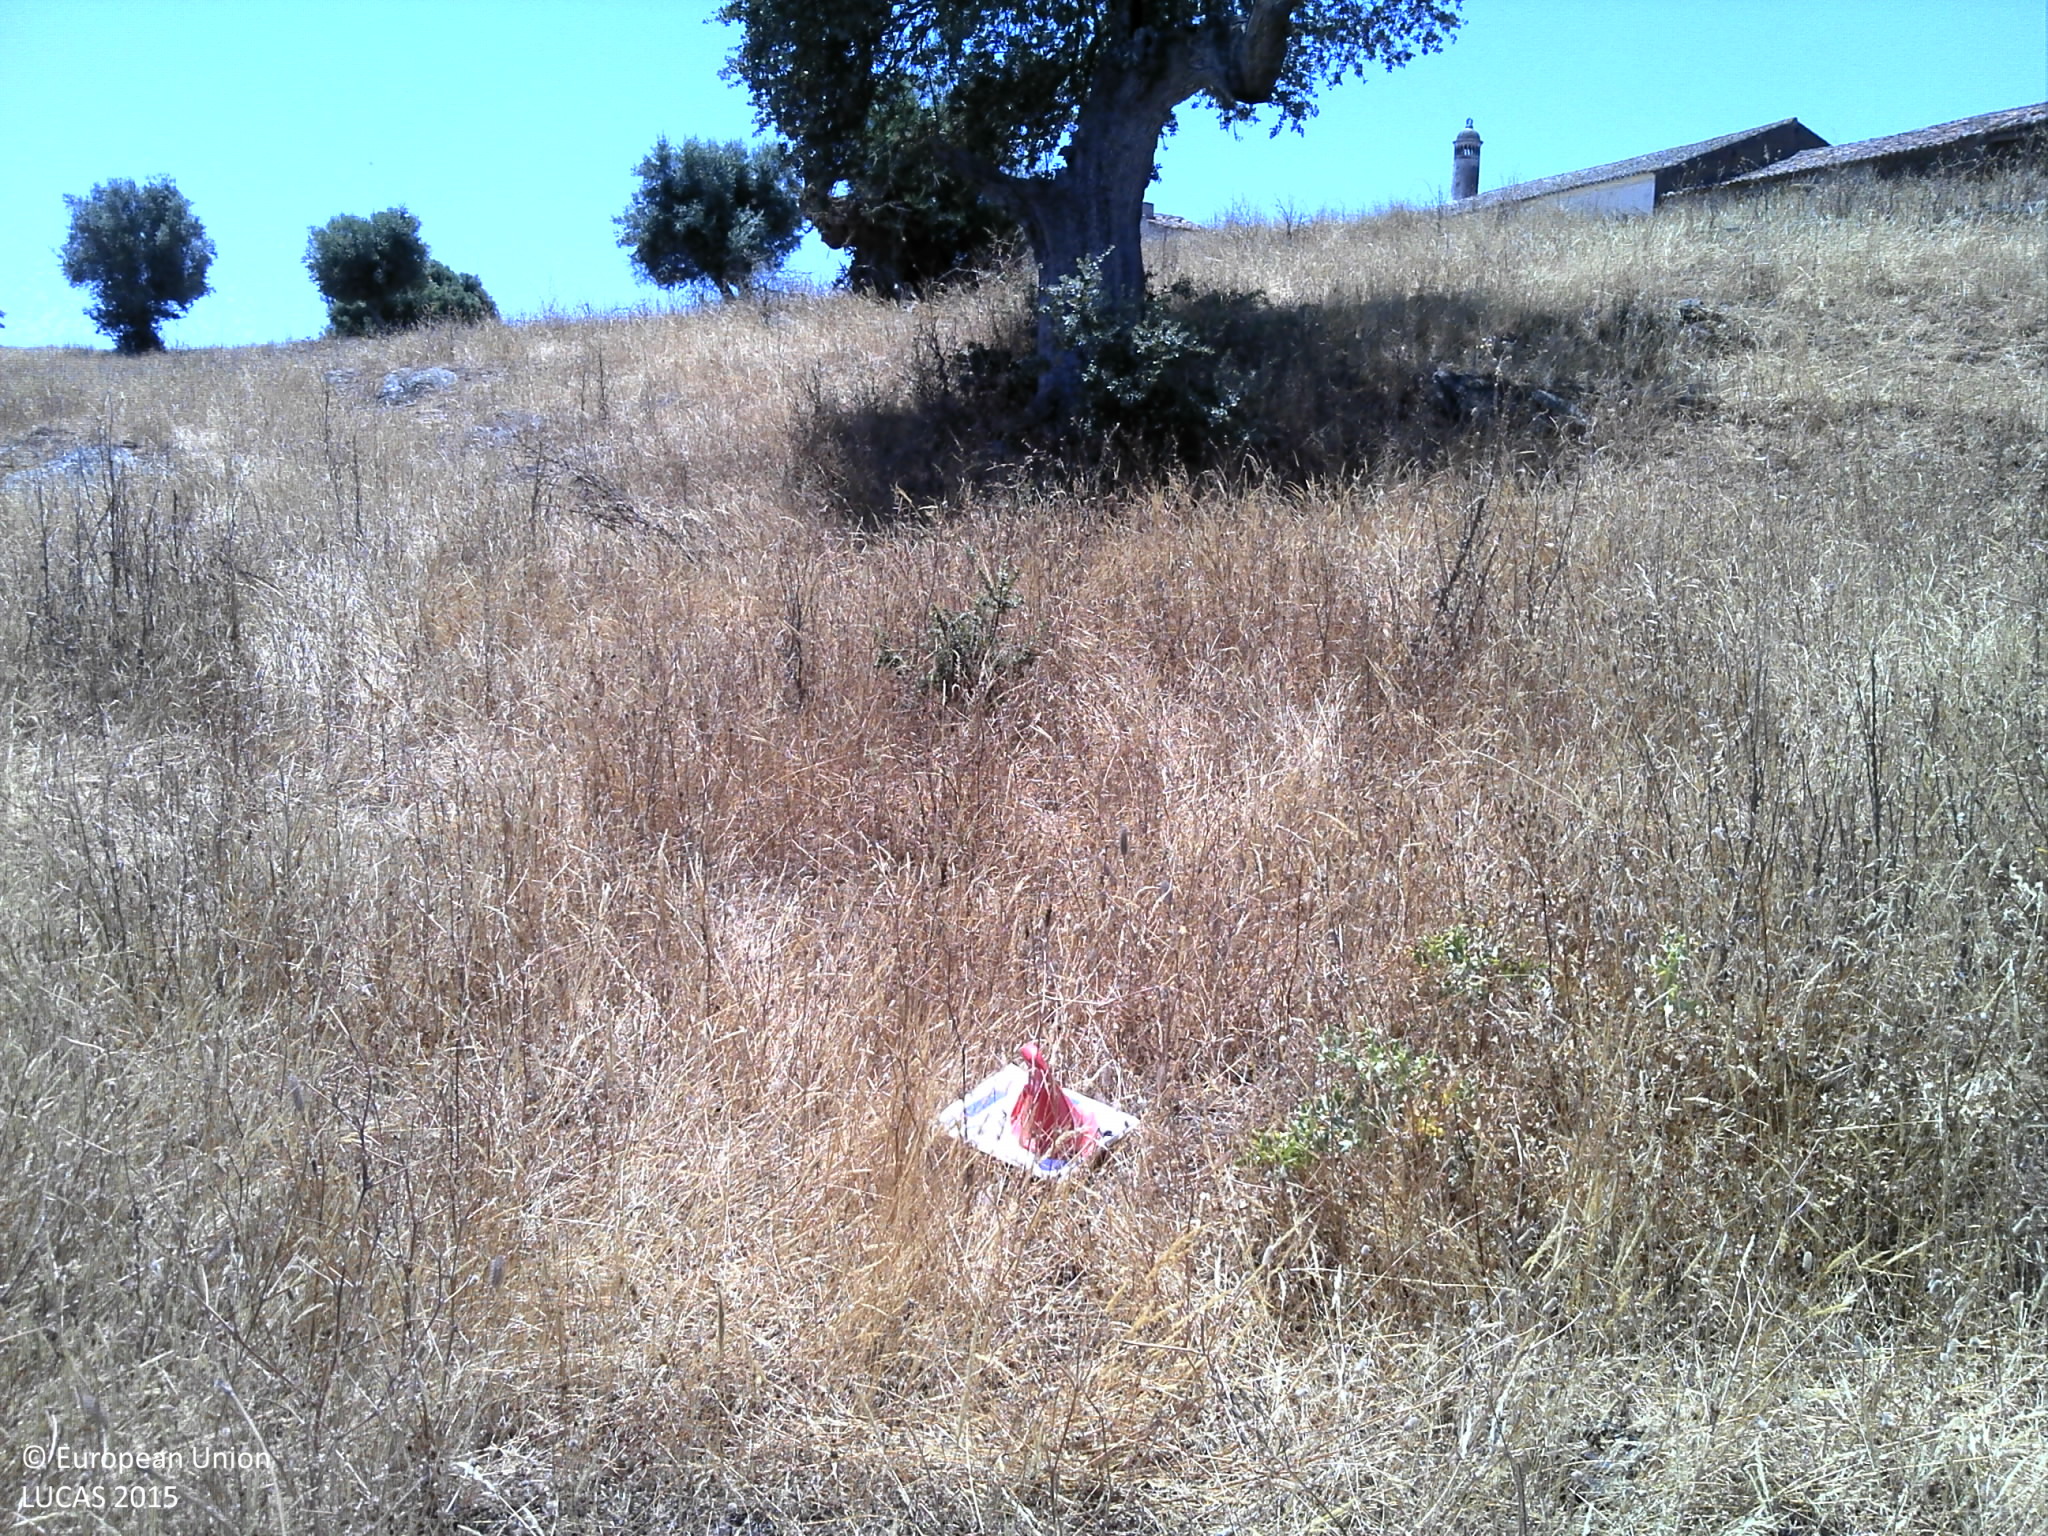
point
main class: Grassland
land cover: Grassland with sparse tree/shrub cover
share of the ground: 50 - 75 %
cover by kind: herbaceous plants 50 %, consolidated bare surface 45 %, broadleaved forest trees 5 %
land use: Agriculture (excluding fallow land and kitchen gardens)
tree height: > 5 m
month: July
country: PT
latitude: 37.7180
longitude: -8.2852
